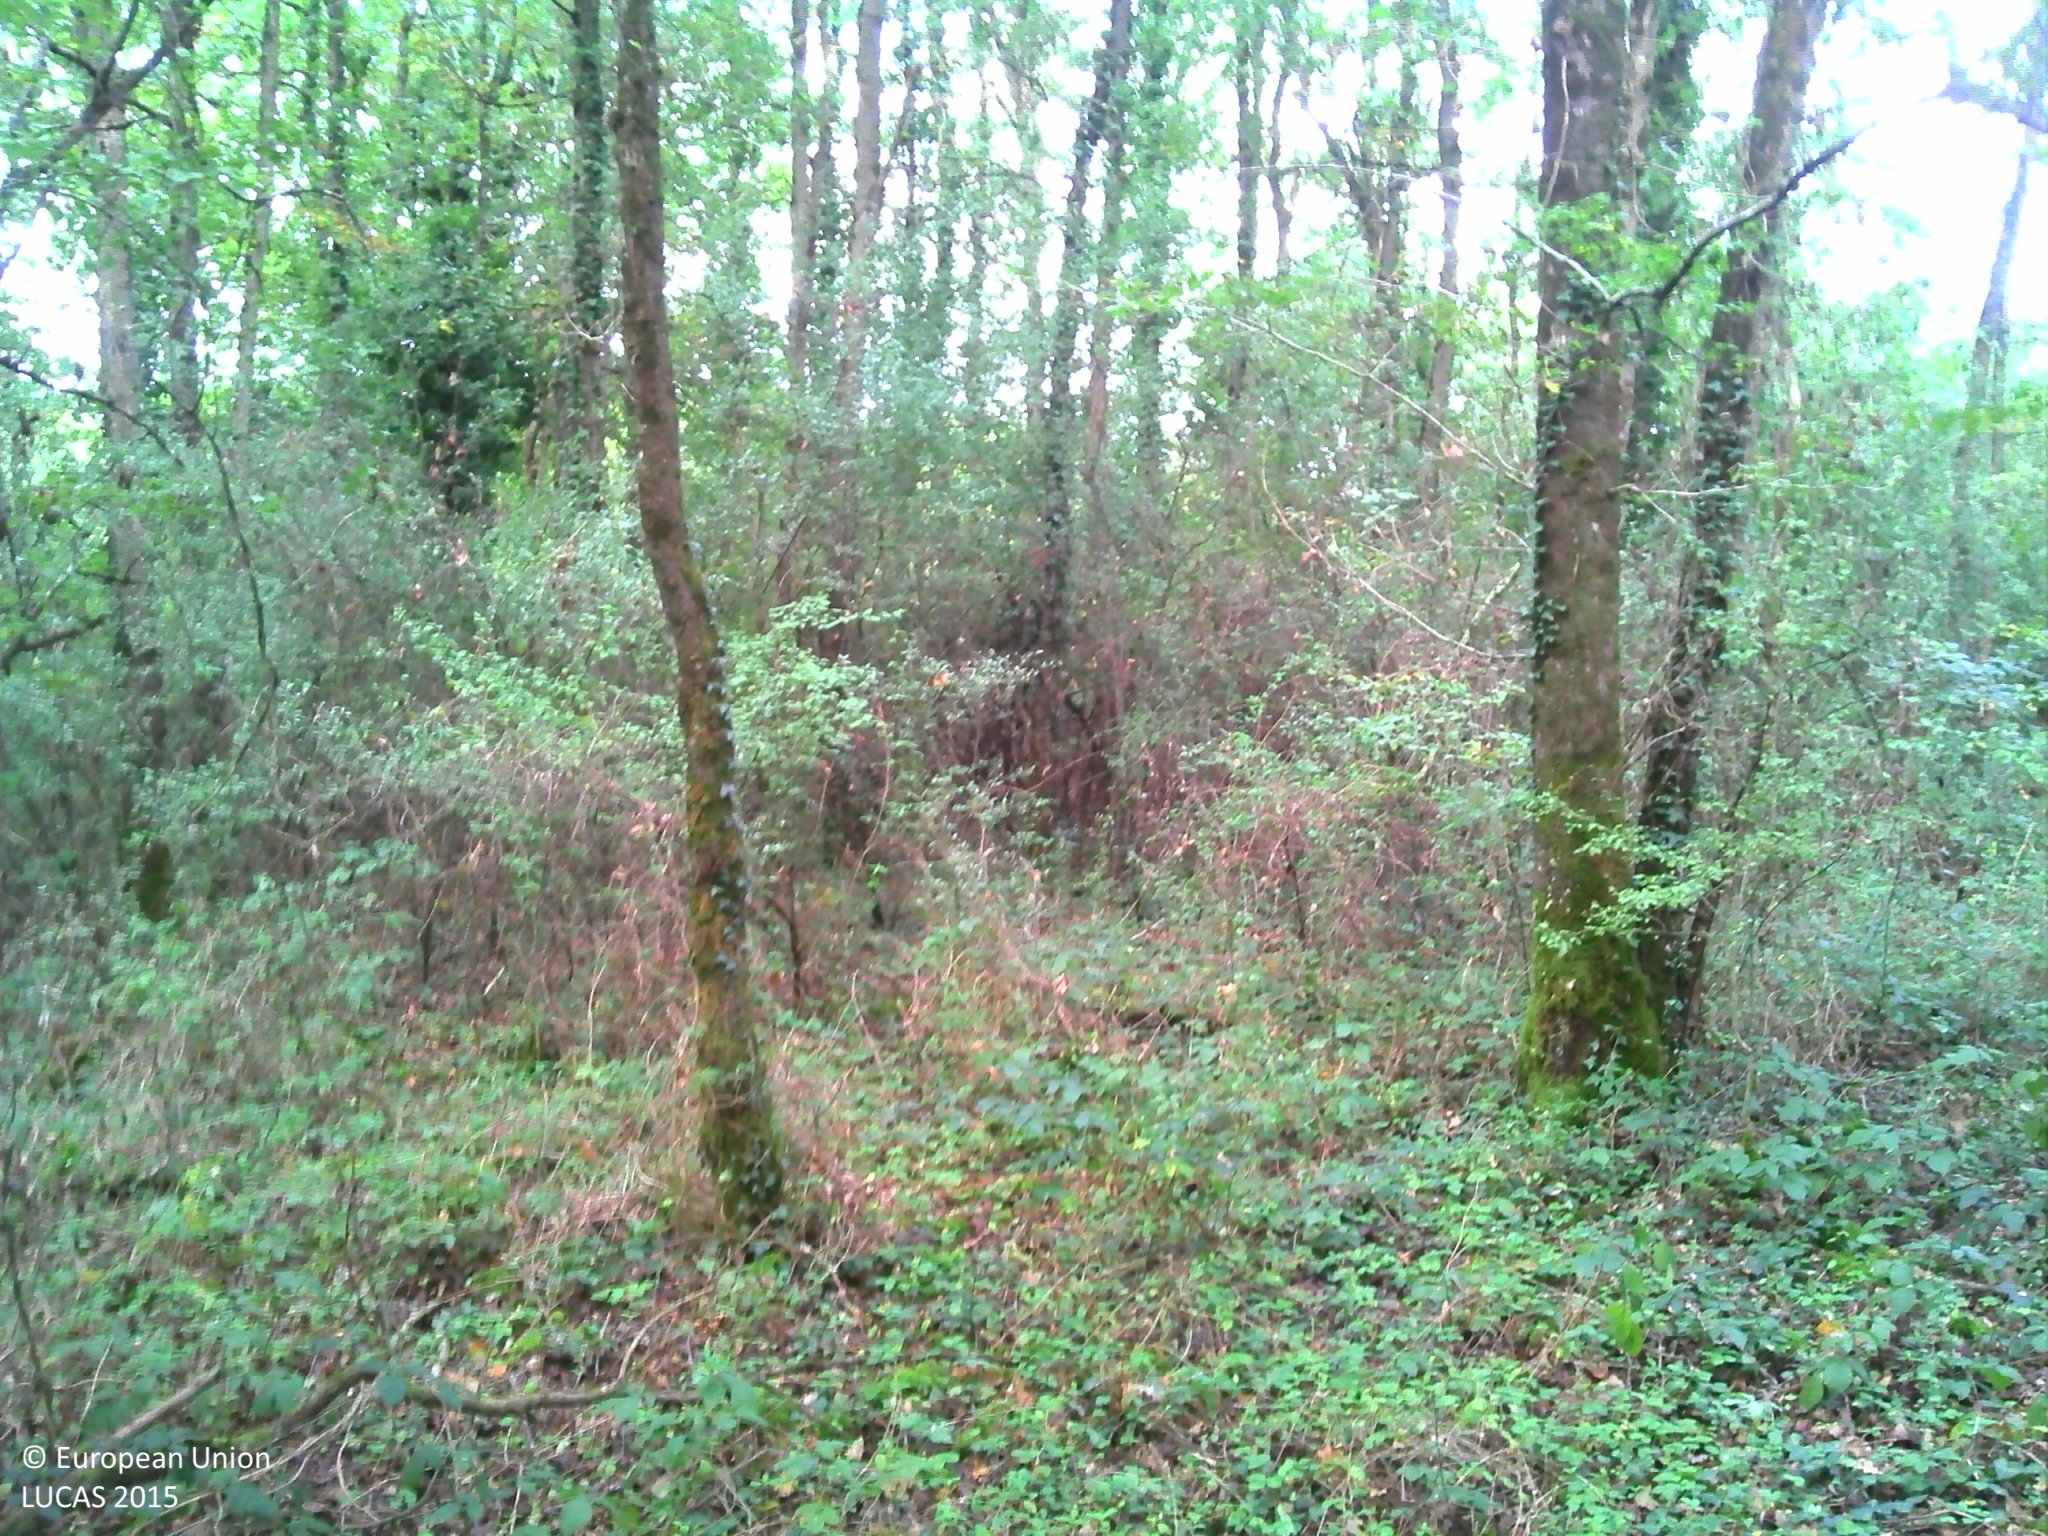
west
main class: Woodland
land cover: Broadleaved woodland
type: mesophytic deciduous forest
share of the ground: > 75 %
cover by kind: broadleaved forest trees 65 %, coniferous forest trees 10 %, shrubs 10 %, herbaceous plants 10 %, lichens and mosses 5 %
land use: Forestry
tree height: > 5 m
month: October
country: FR
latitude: 47.0217
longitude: 0.5742
